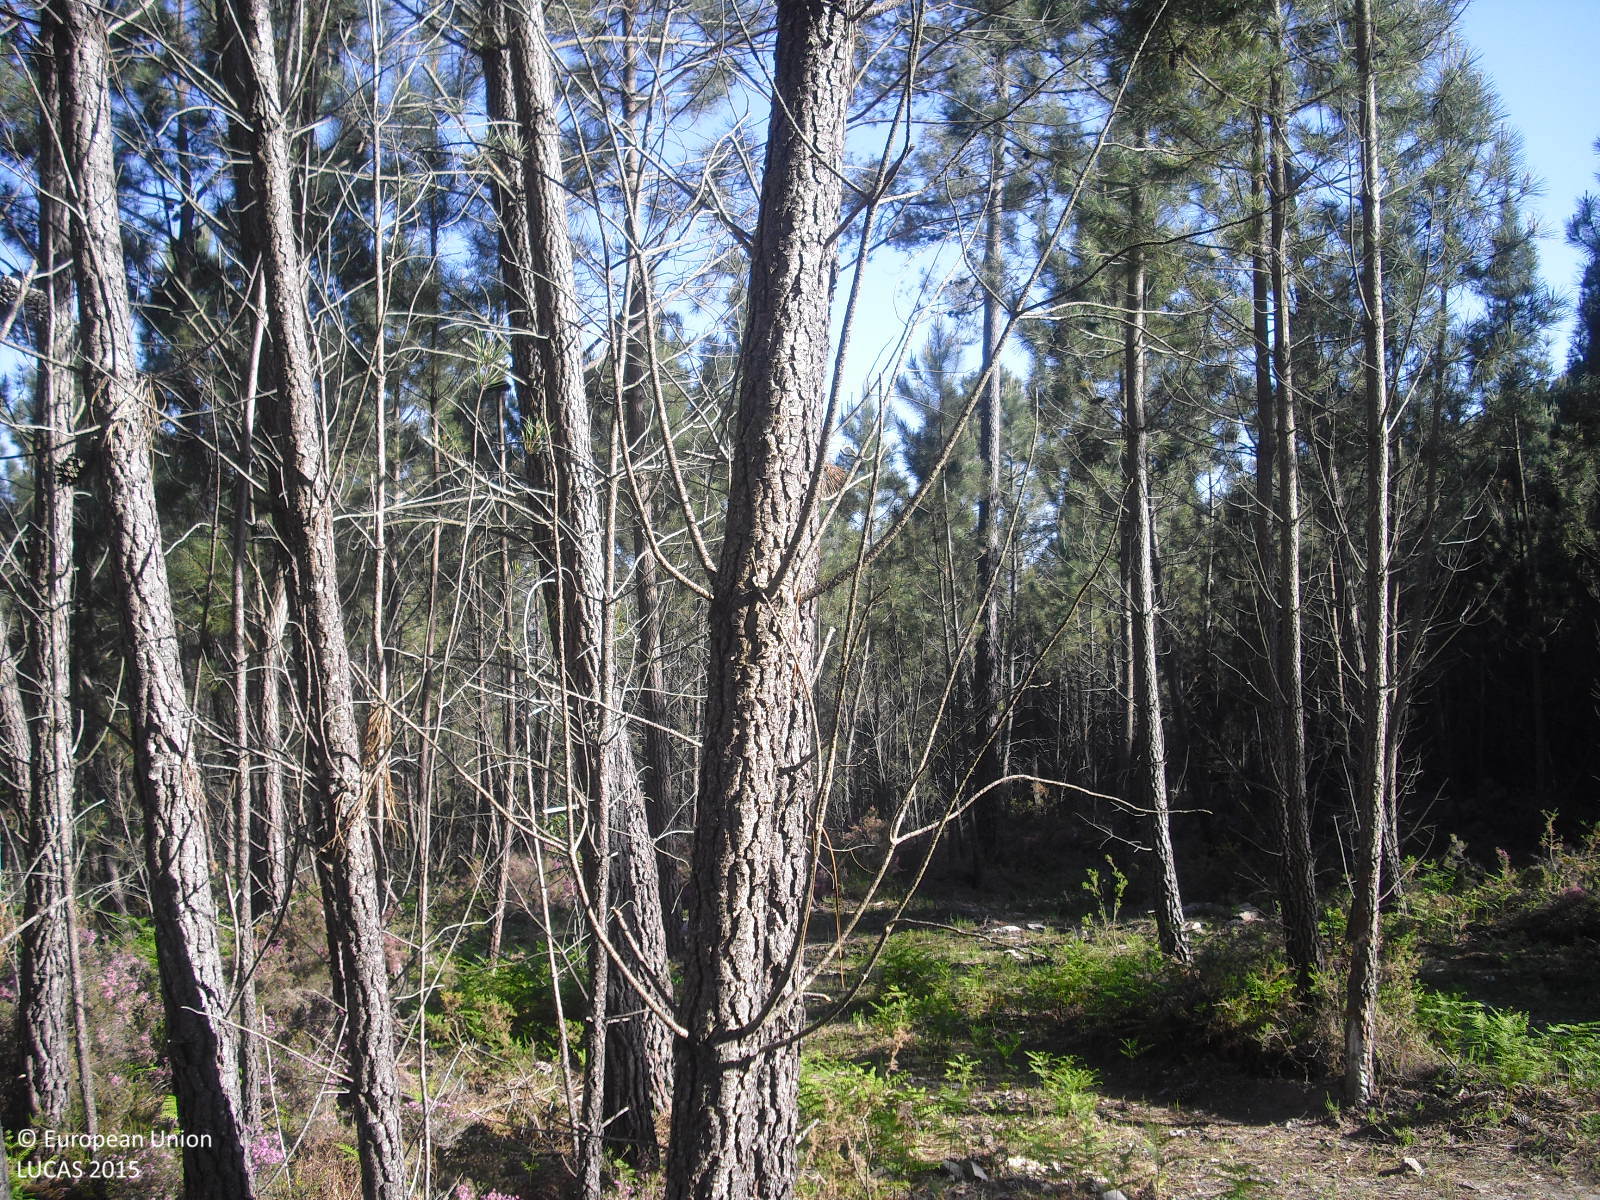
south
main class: Woodland
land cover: Pine dominated coniferous woodland
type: exotic forest
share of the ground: 25 - 50 %
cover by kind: shrubs 60 %, coniferous forest trees 40 %
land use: Forestry
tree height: > 5 m
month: May
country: ES
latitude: 41.9204
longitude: -8.1541
